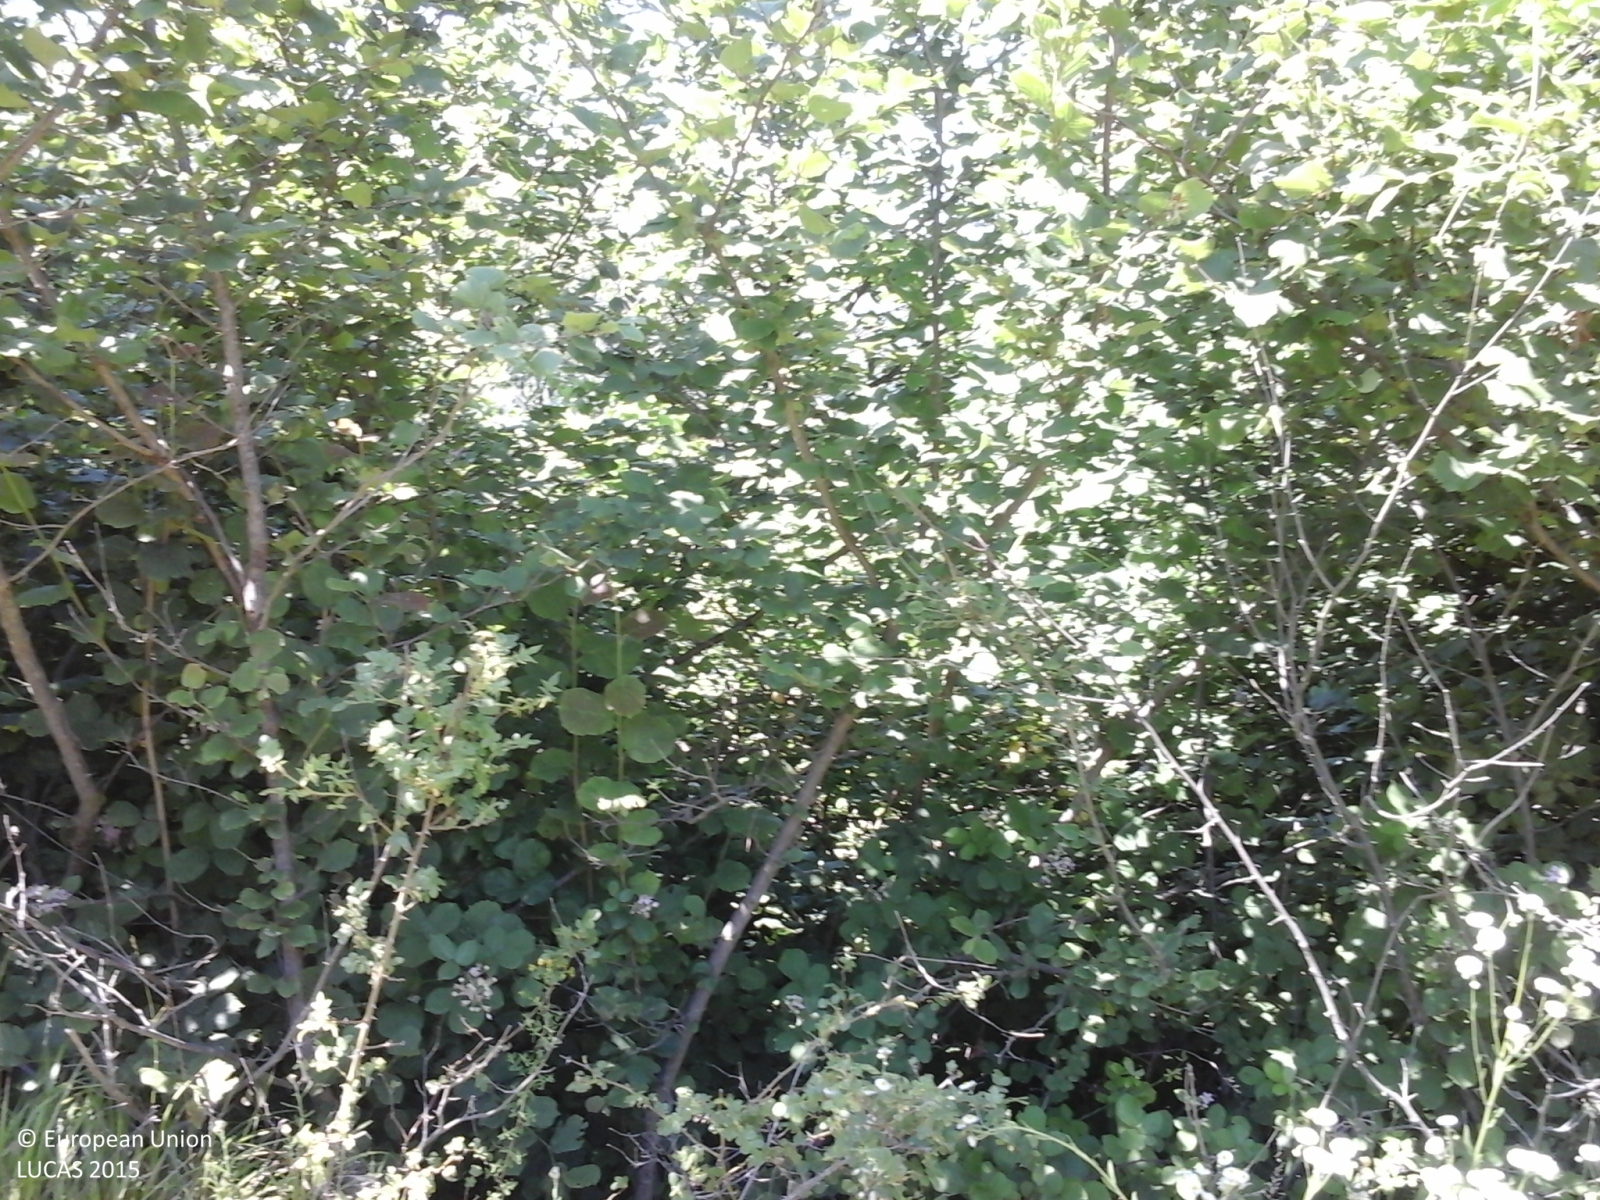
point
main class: Woodland
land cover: Broadleaved woodland
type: thermophilous deciduous forest
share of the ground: > 75 %
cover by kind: broadleaved forest trees 95 %, herbaceous plants 5 %
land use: Semi-natural and natural areas not in use
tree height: > 5 m
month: June
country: IT
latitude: 44.5708
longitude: 8.2785
